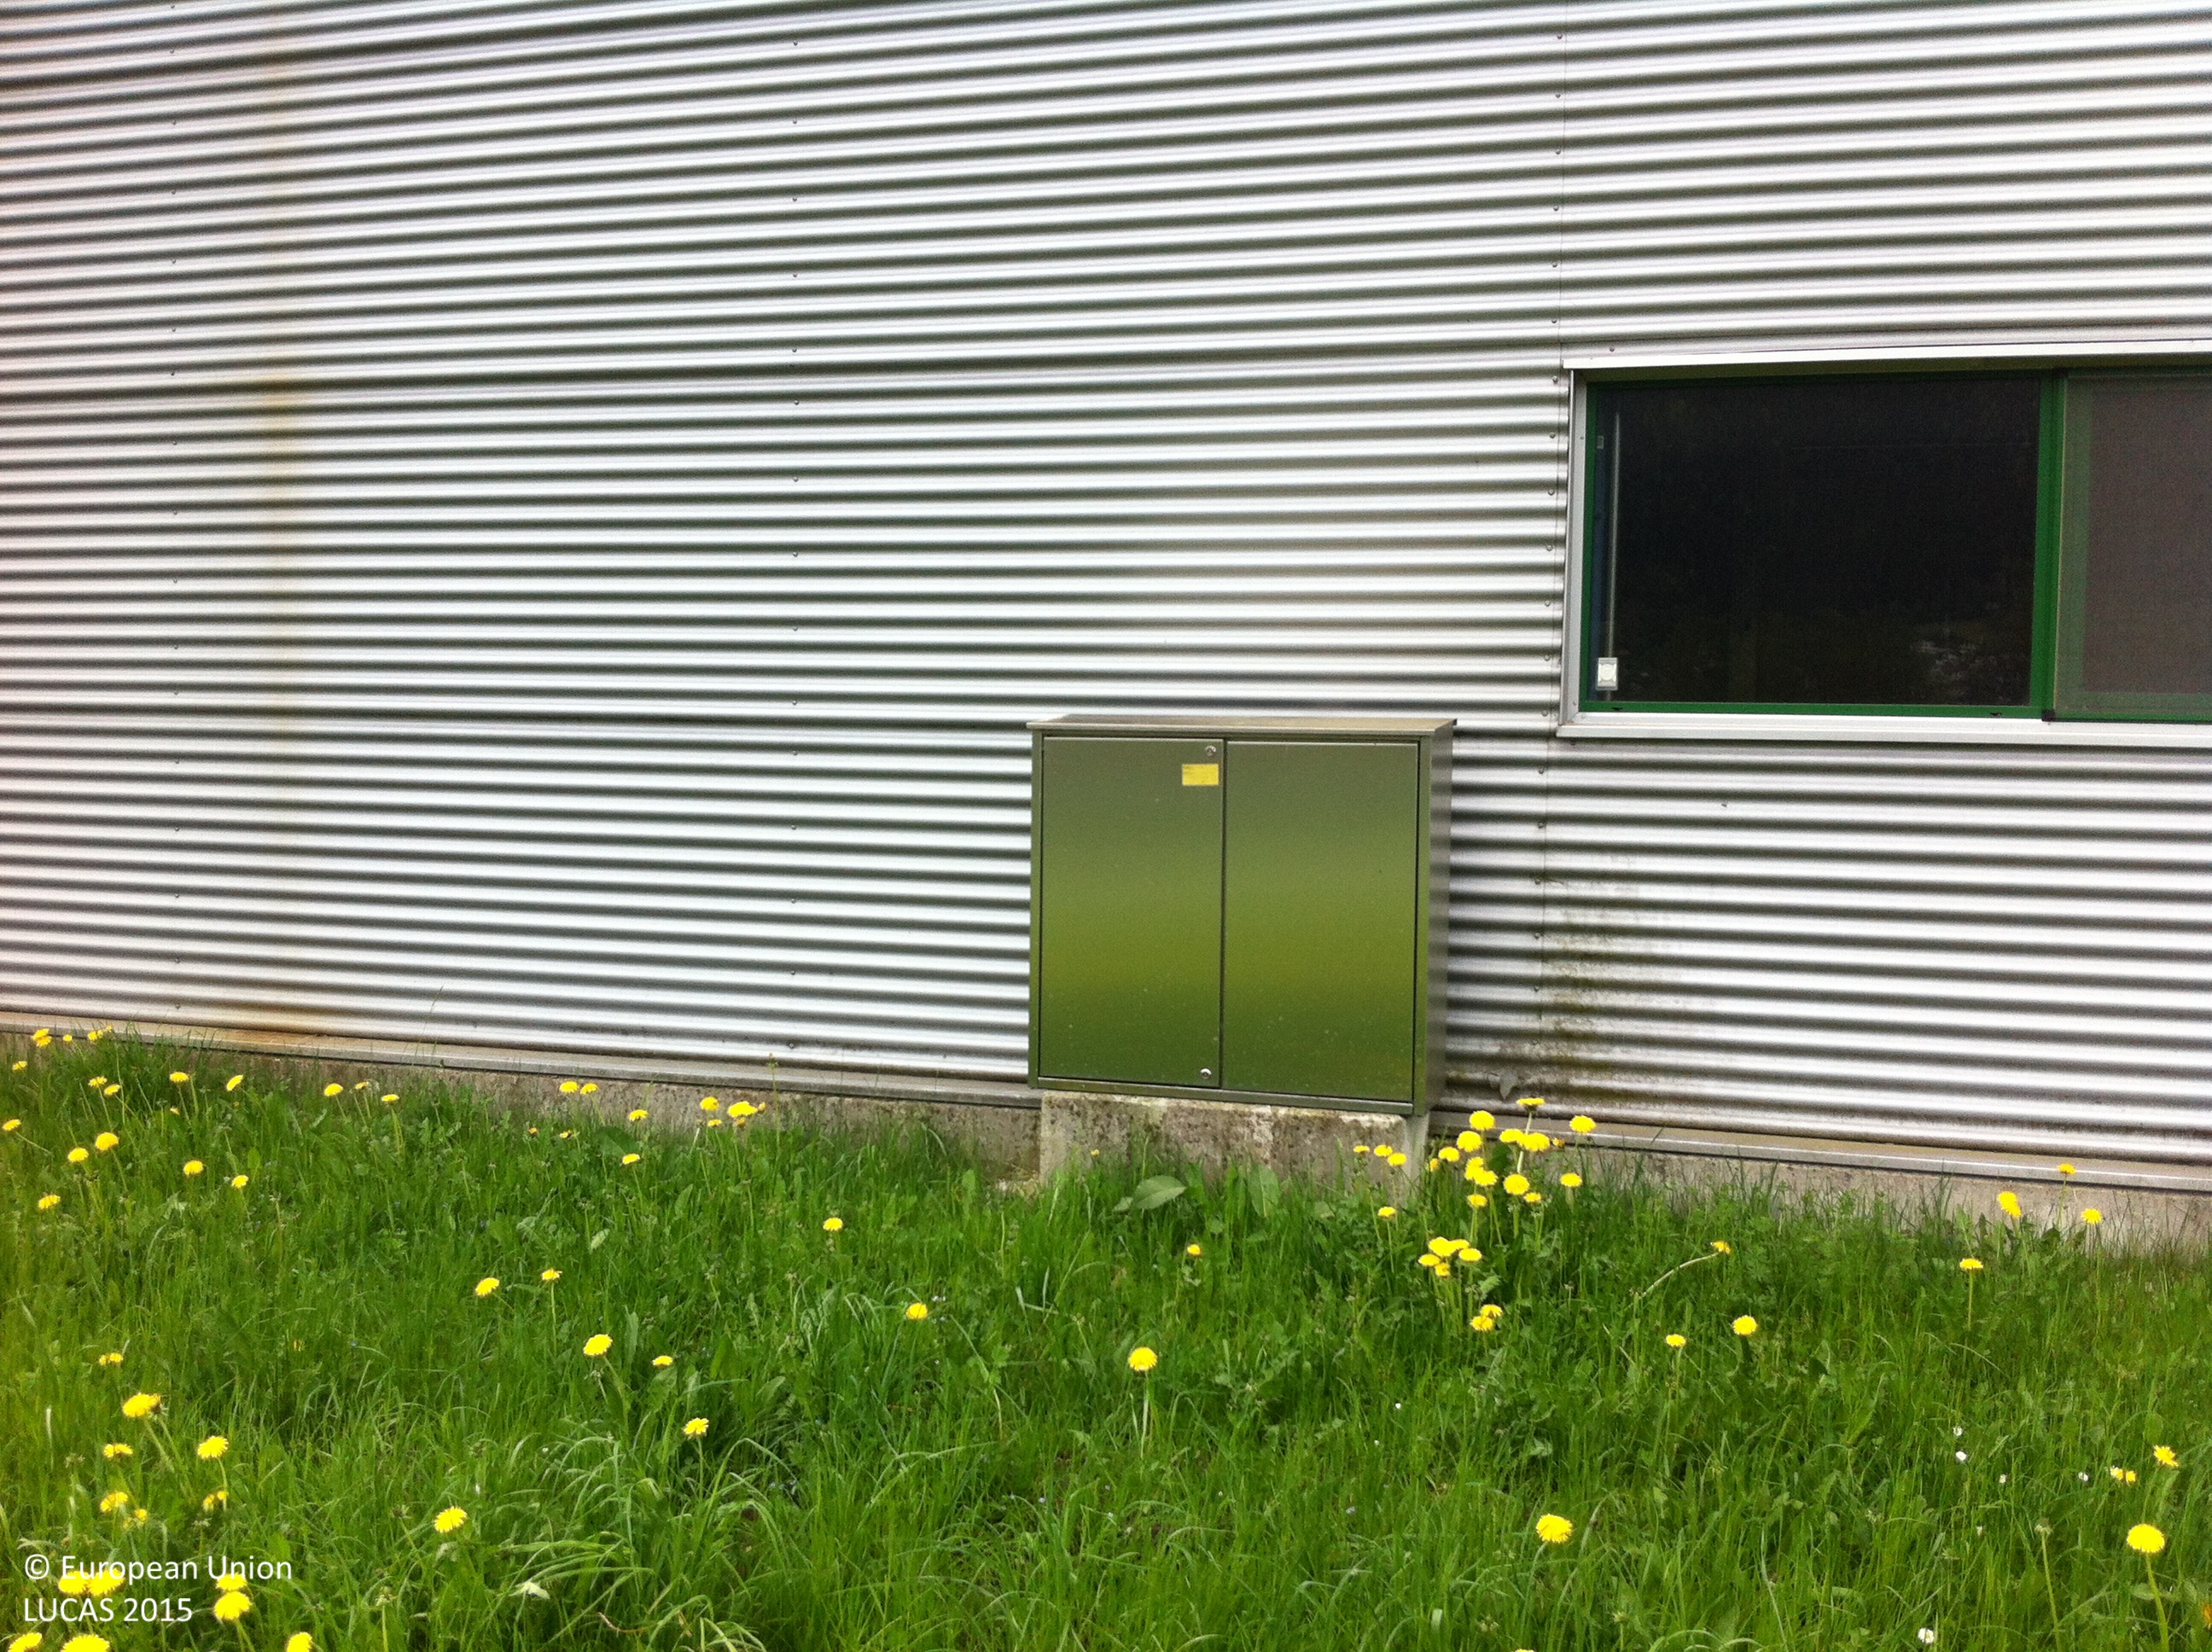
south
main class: Grassland
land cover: Grassland without tree/shrub cover
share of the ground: > 75 %
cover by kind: herbaceous plants 100 %
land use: Agriculture (excluding fallow land and kitchen gardens)
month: May
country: AT
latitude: 47.3801
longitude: 11.8396
